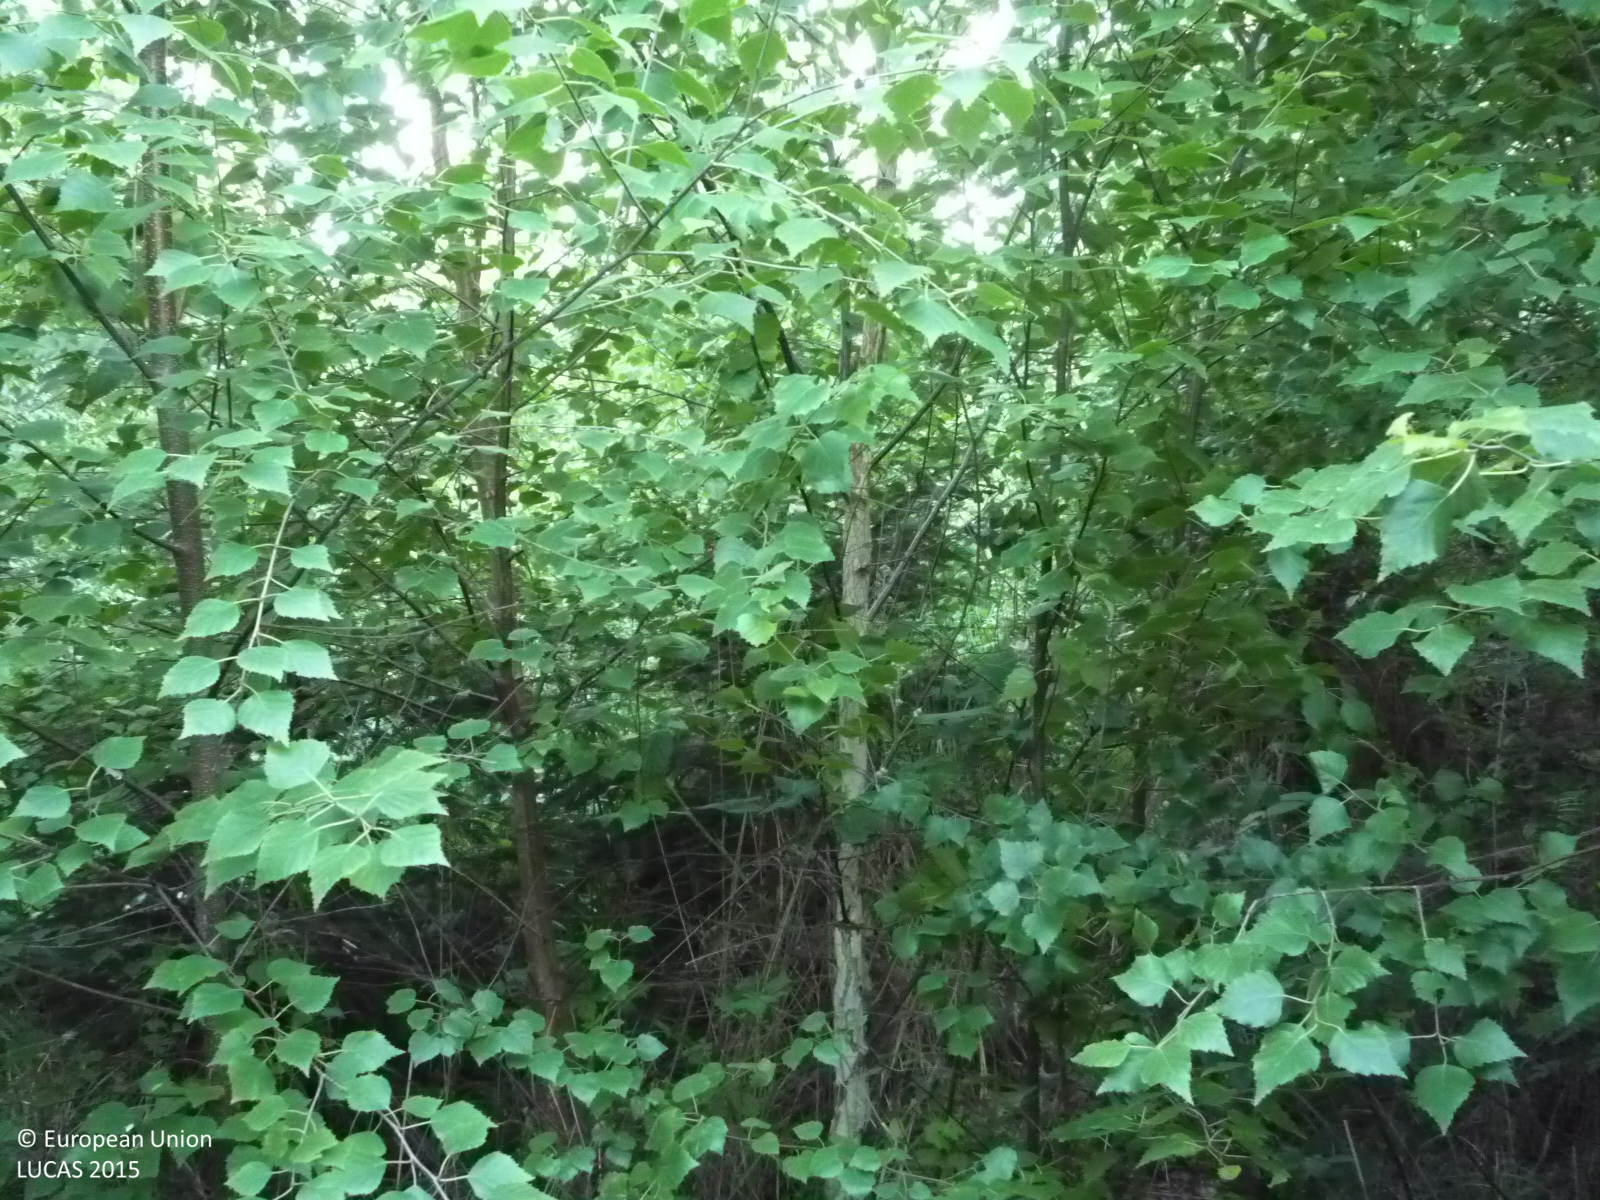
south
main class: Woodland
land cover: Spruce dominated mixed woodland
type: hemiboreal forest and nemoral coniferous forest and mixed broadleaved-coniferous forest
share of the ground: > 75 %
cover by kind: broadleaved forest trees 55 %, coniferous forest trees 30 %, shrubs 15 %
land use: Forestry
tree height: > 5 m
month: June
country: CZ
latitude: 49.7806
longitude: 15.1275
